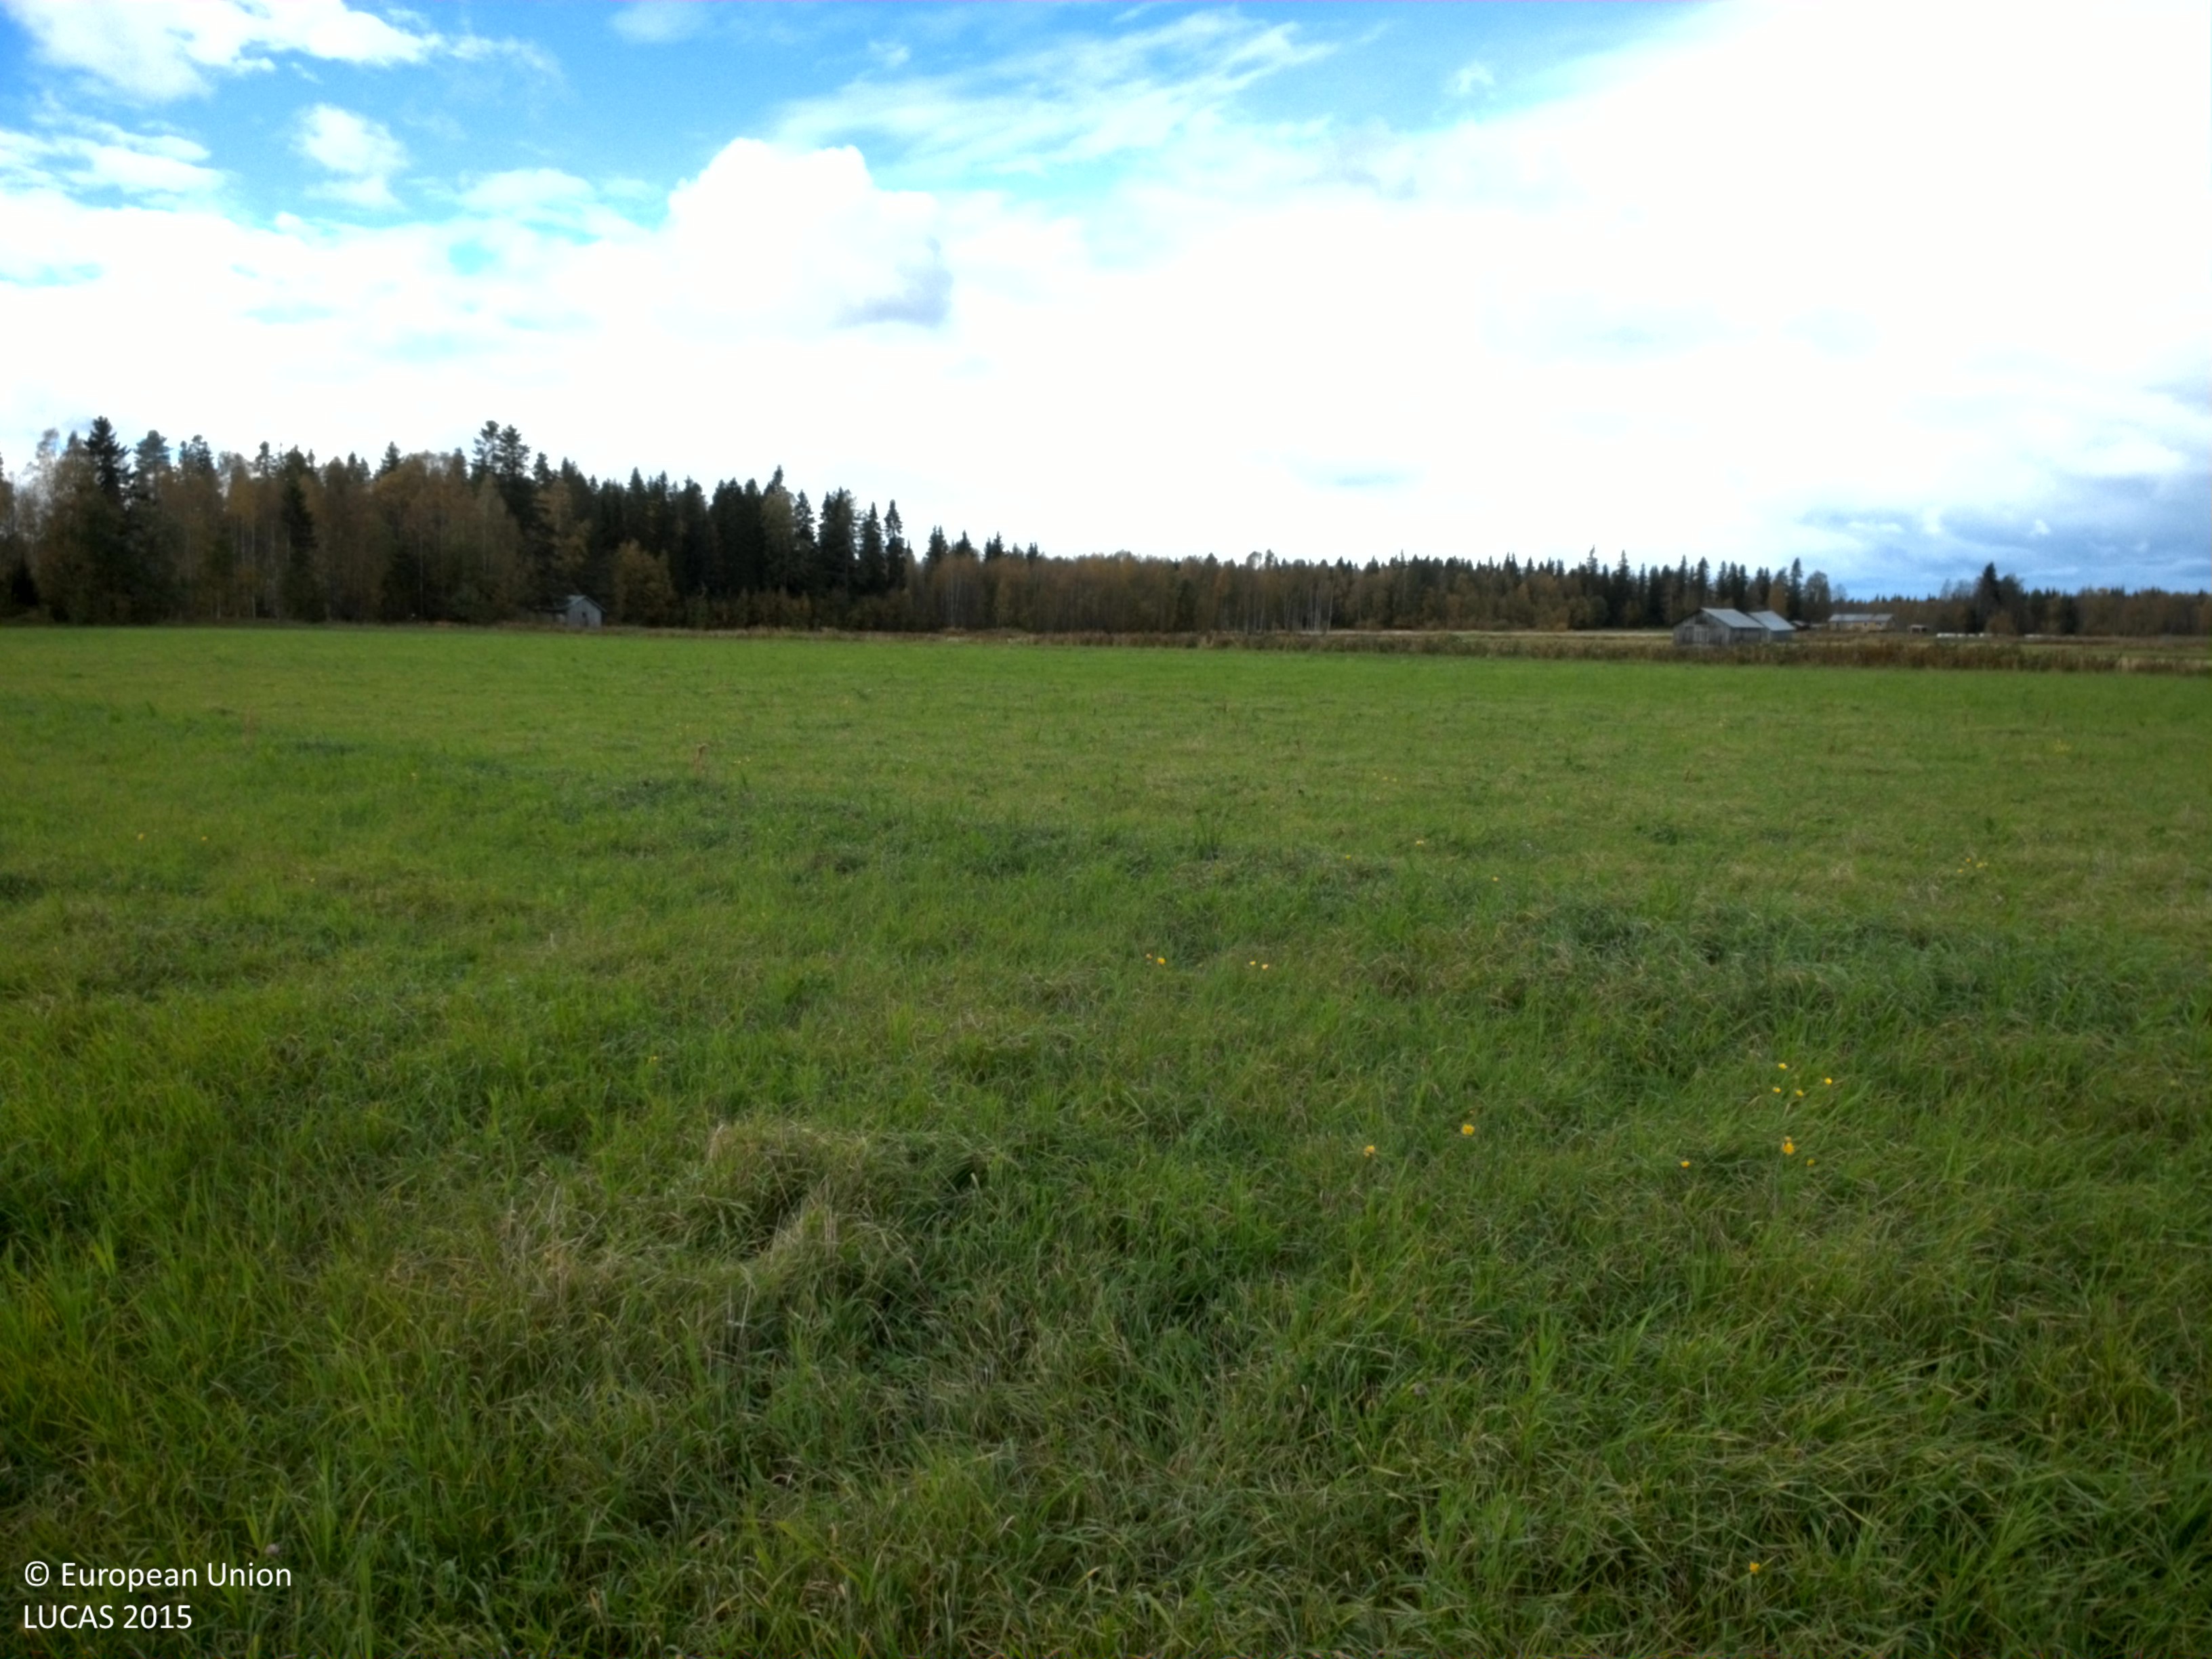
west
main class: Cropland
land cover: Temporary grasslands
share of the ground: > 75 %
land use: Agriculture (excluding fallow land and kitchen gardens)
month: September
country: SE
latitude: 65.7009
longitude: 22.2405
